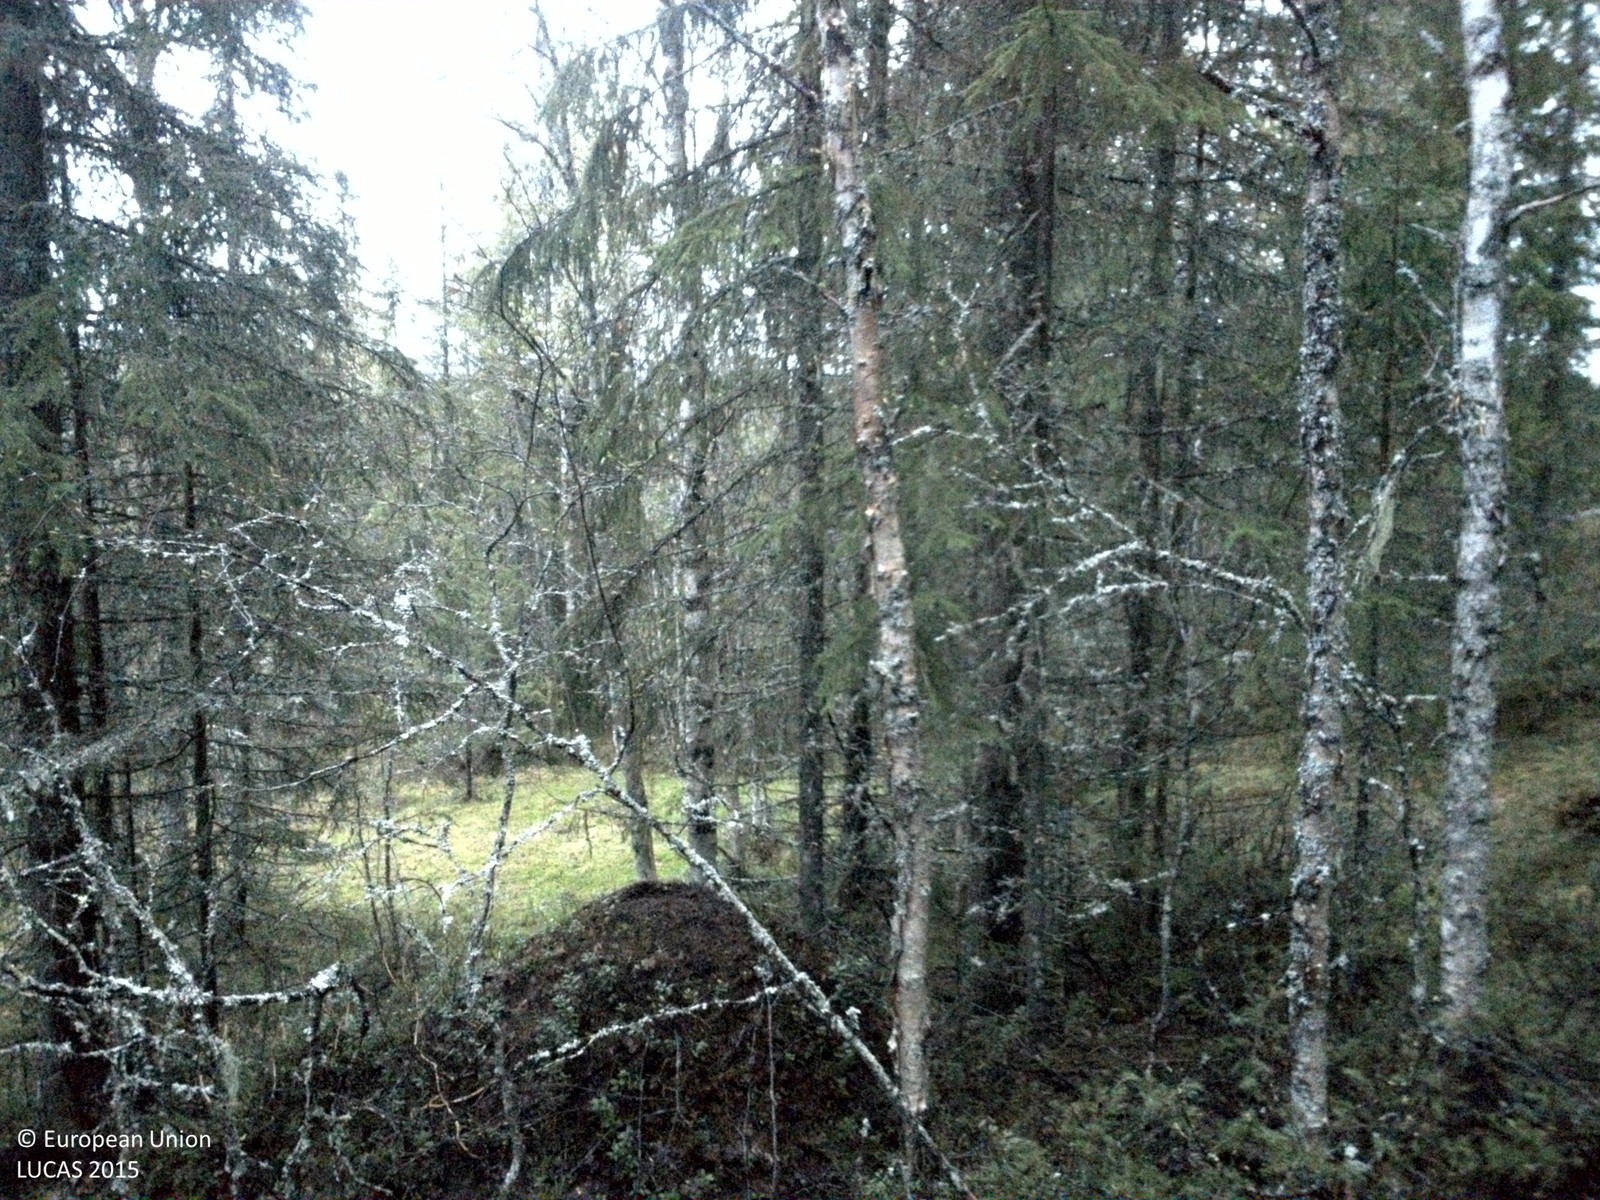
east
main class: Woodland
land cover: Spruce dominated mixed woodland
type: boreal forest
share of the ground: > 75 %
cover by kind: coniferous forest trees 65 %, broadleaved forest trees 25 %, shrubs 10 %
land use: Forestry
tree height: > 5 m
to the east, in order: Spruce dominated mixed woodland; Shrubland without tree cover; Spruce dominated mixed woodland
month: June
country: SE
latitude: 61.0267
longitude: 13.2278
